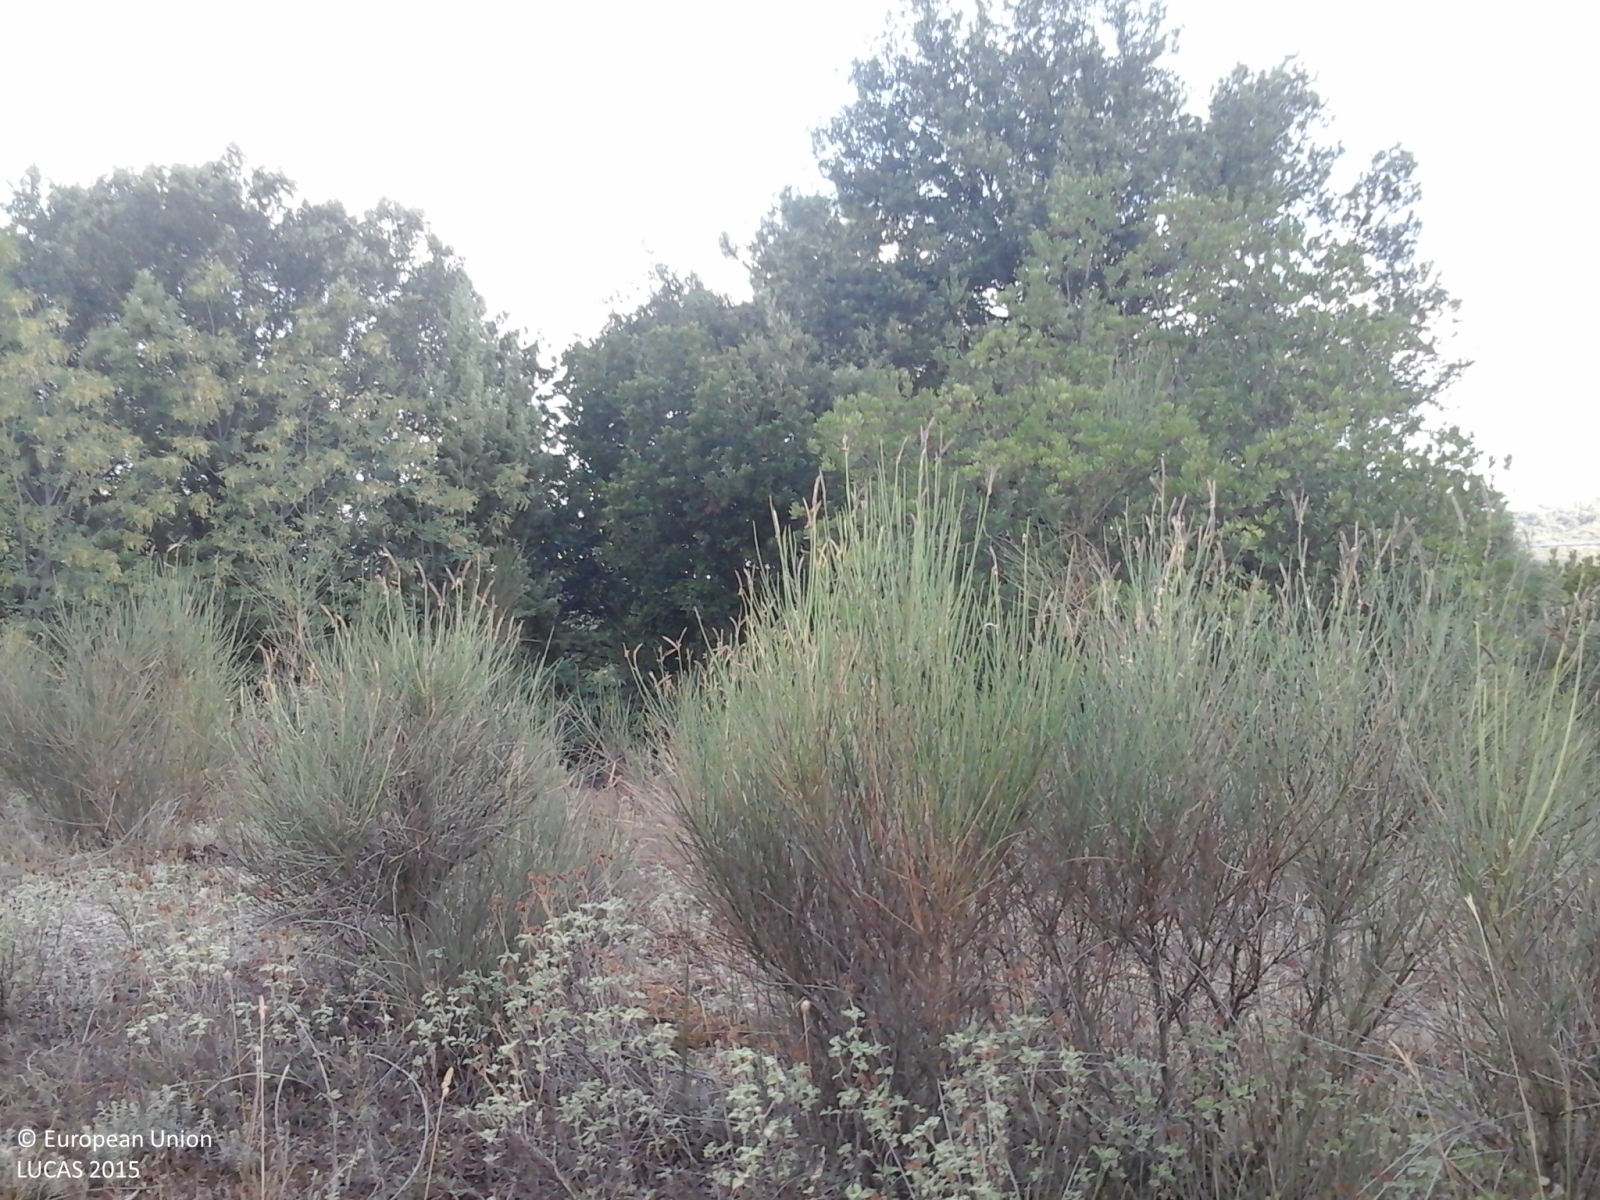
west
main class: Woodland
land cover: Other mixed woodland
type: thermophilous deciduous forest
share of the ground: > 75 %
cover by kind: broadleaved forest trees 60 %, coniferous forest trees 40 %
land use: Forestry
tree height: > 5 m
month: July
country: IT
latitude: 43.4804
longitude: 10.9246
